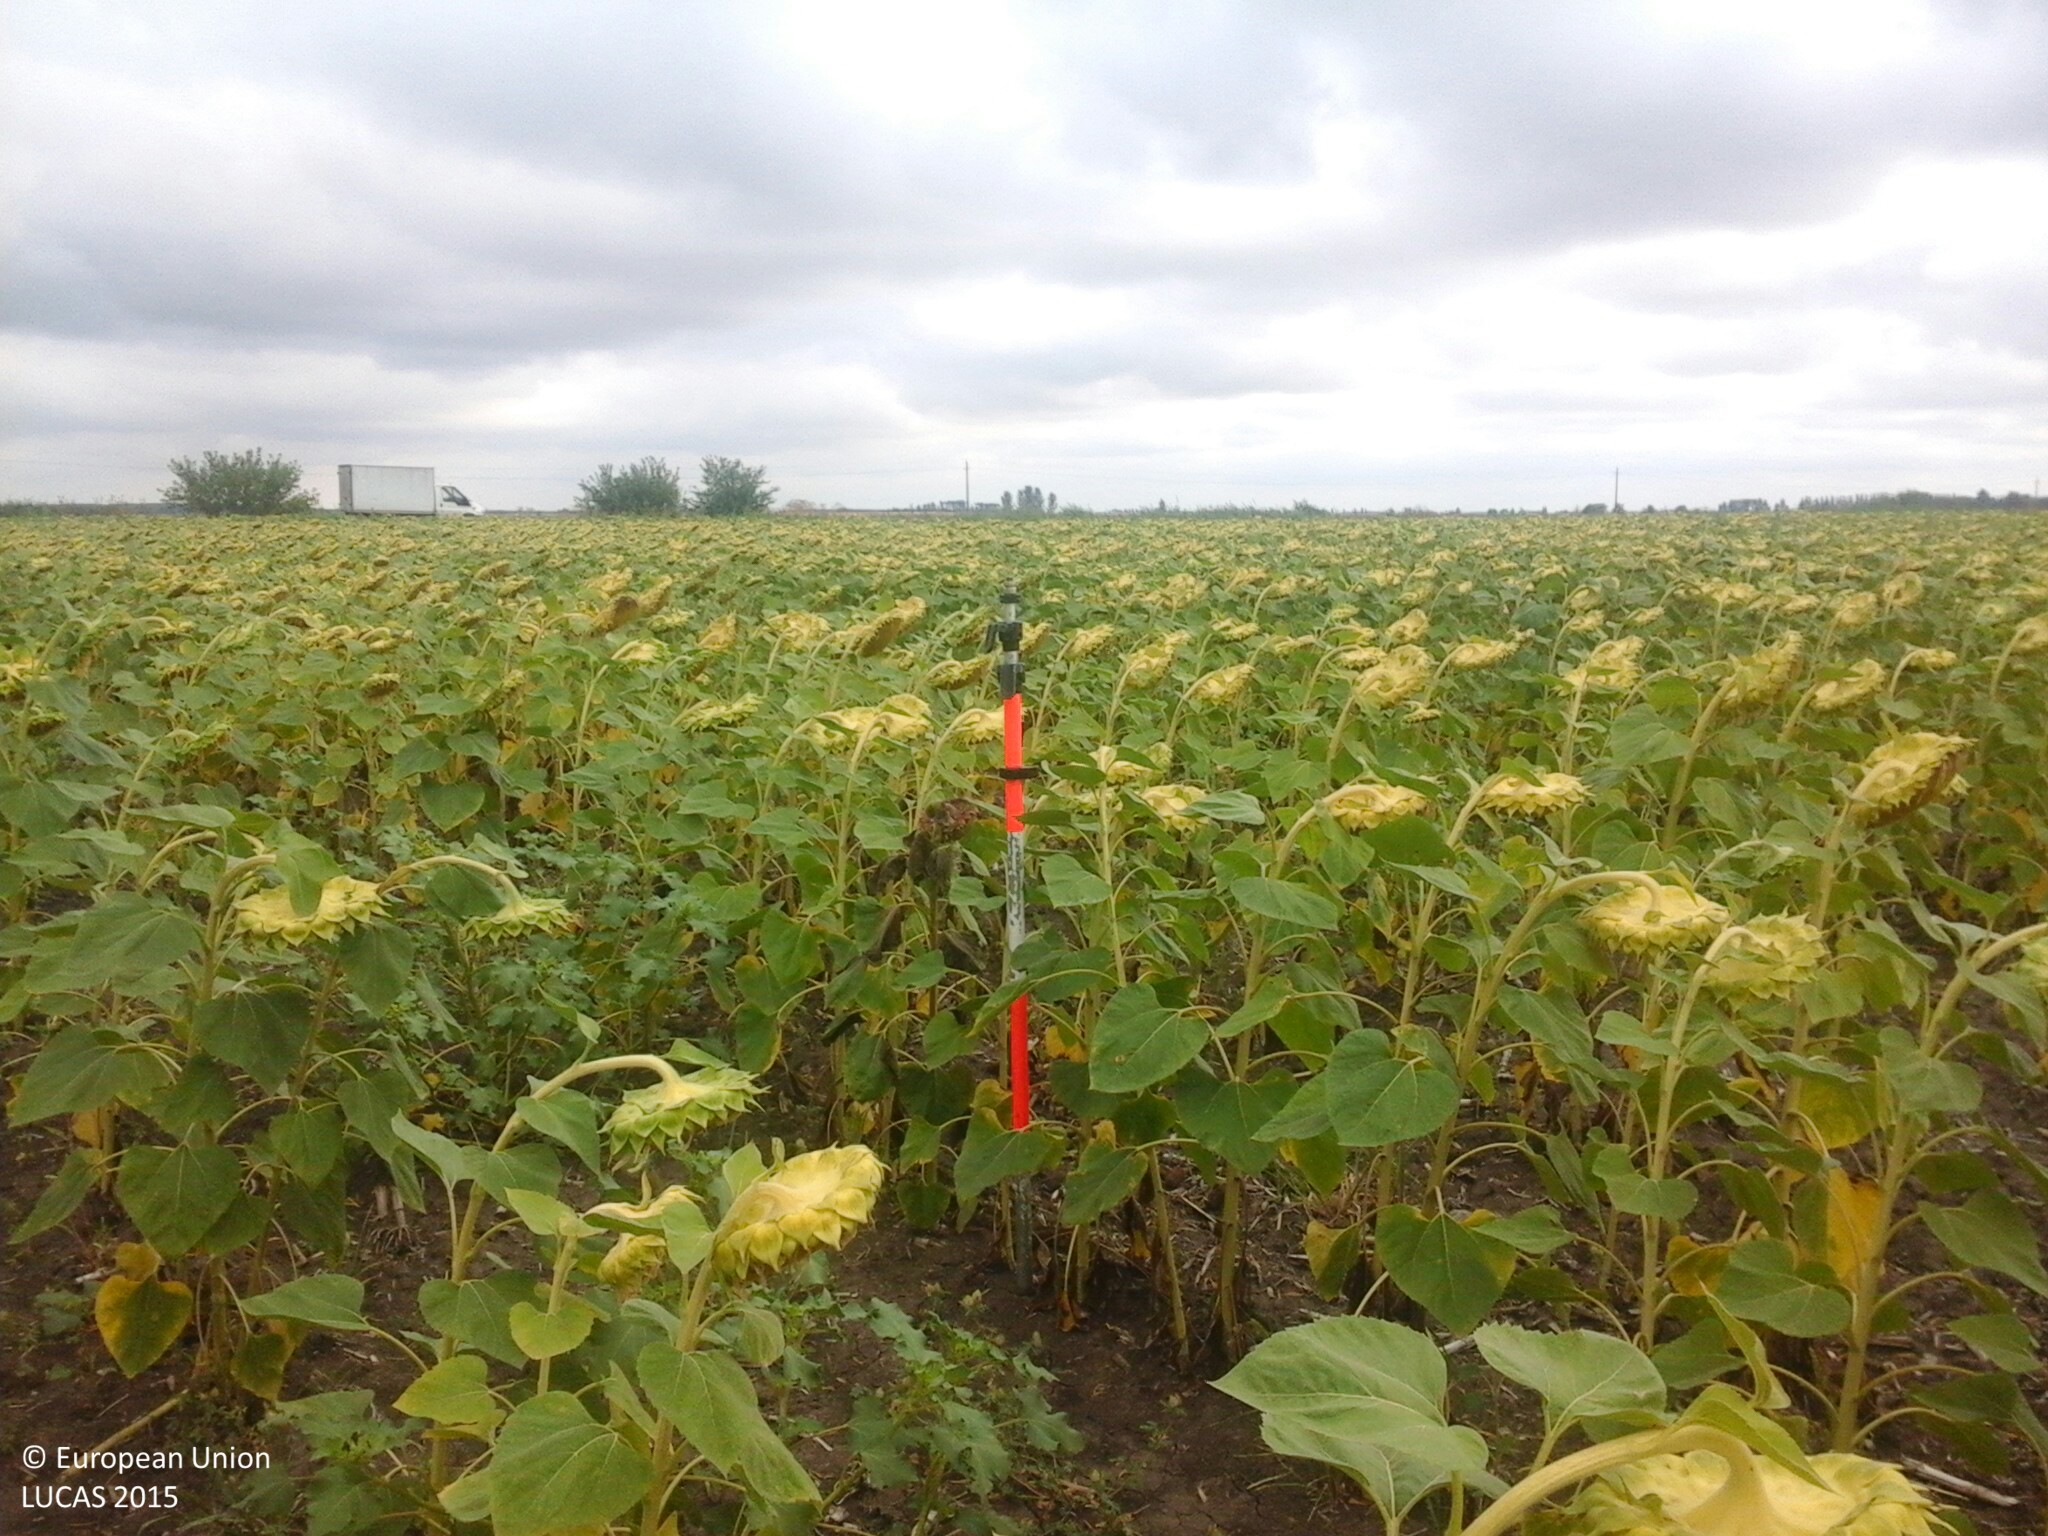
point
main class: Cropland
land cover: Sunflower
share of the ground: 50 - 75 %
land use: Agriculture (excluding fallow land and kitchen gardens)
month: August
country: HU
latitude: 47.0170
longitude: 21.5253
